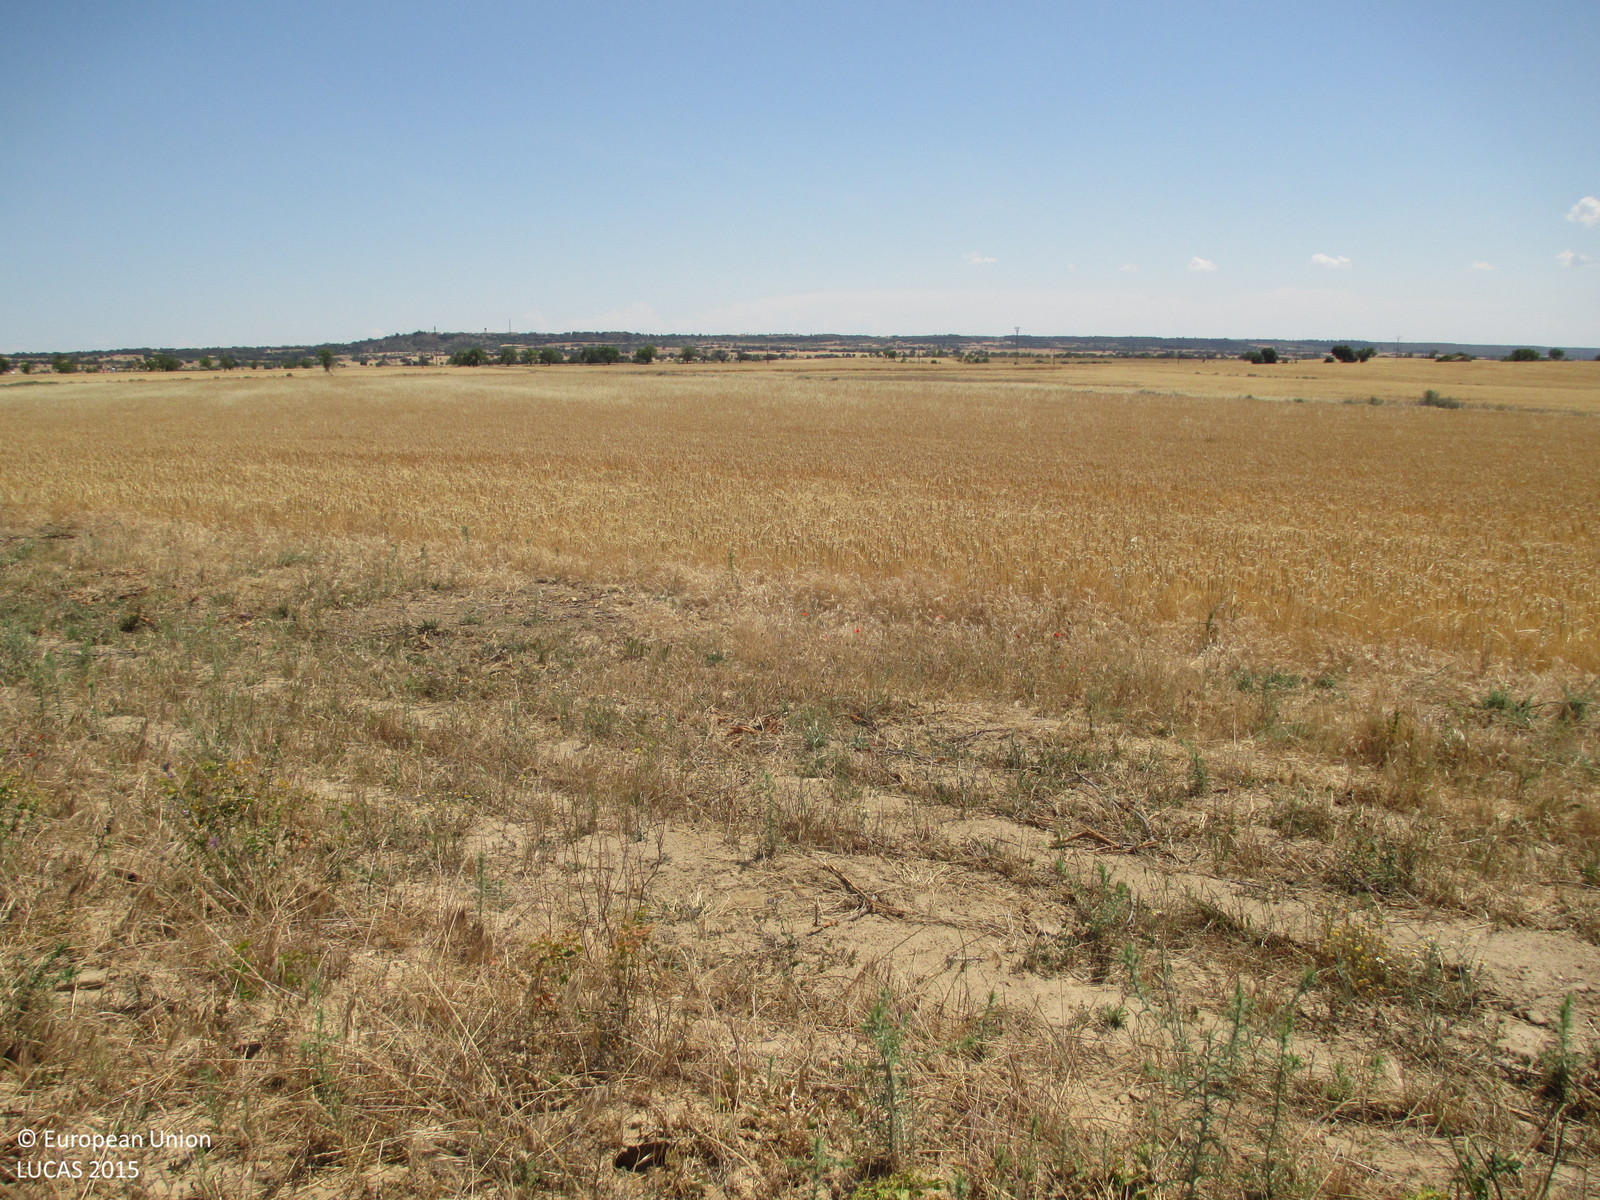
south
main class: Grassland
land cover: Spontaneously vegetated surfaces
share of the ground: 50 - 75 %
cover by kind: herbaceous plants 65 %, unconsolidated bare surface 35 %
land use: Fallow land
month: May
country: ES
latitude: 41.9559
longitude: -0.0199
